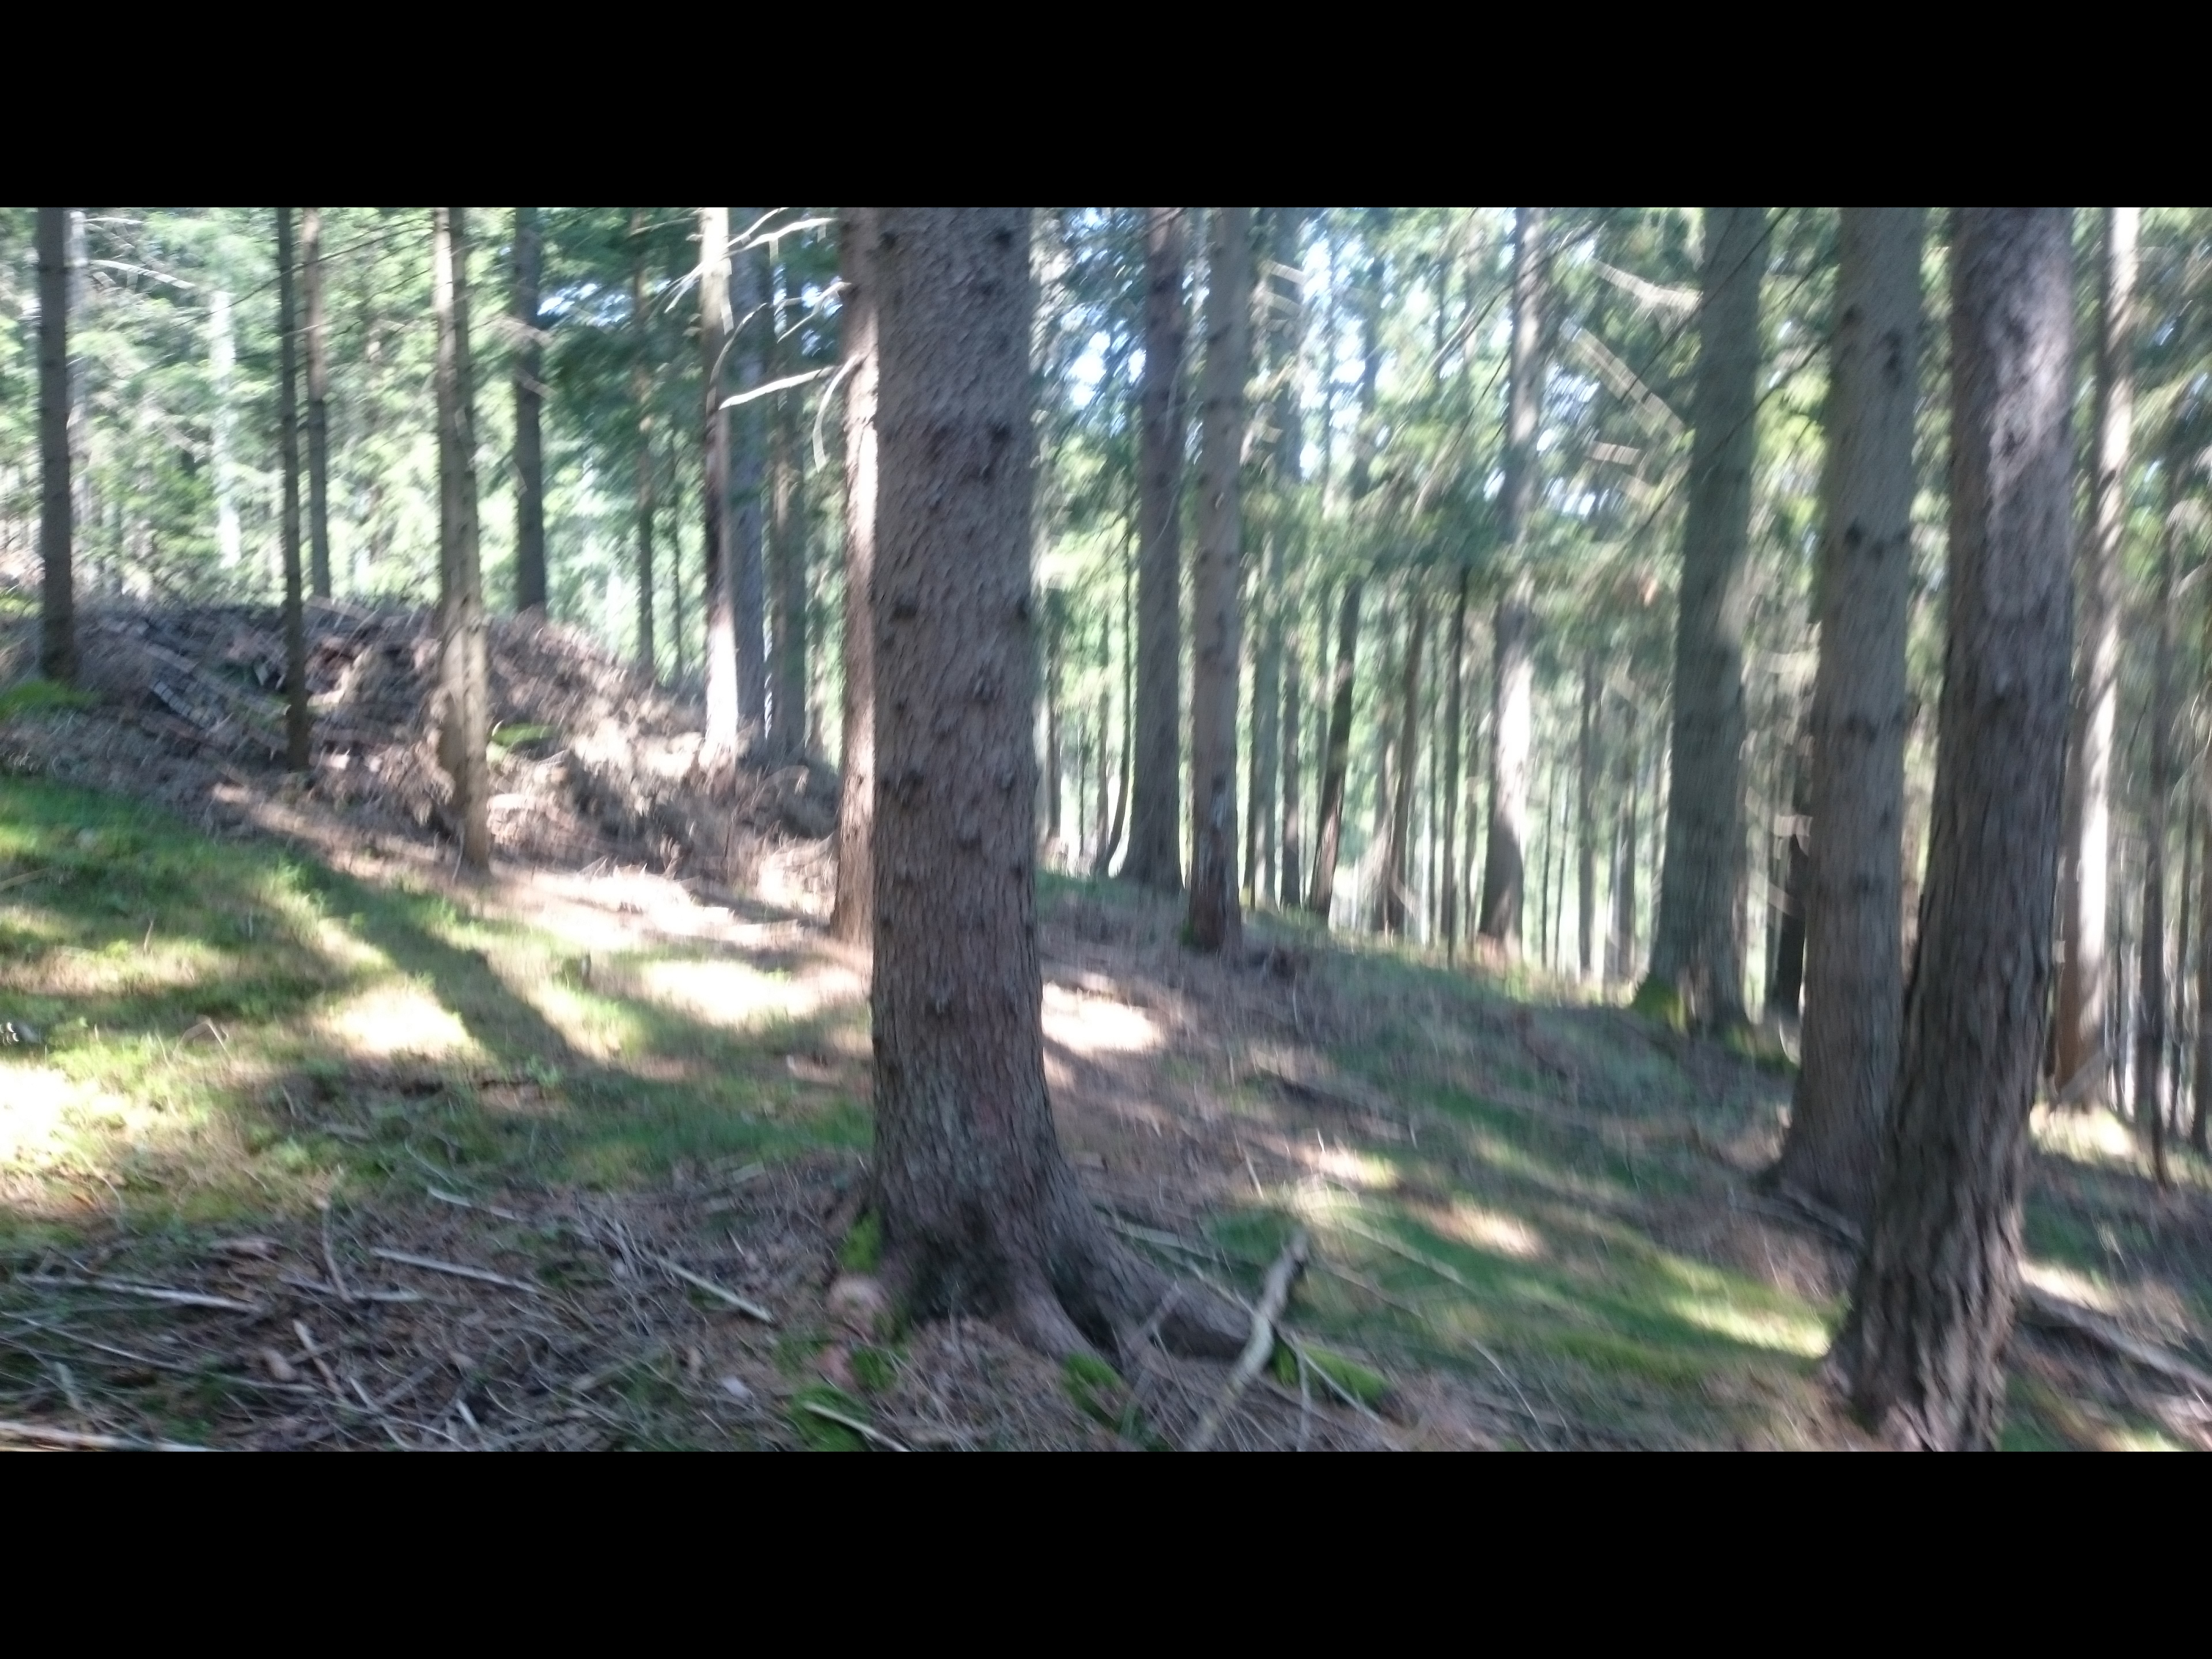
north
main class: Woodland
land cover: Spruce dominated coniferous woodland
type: hemiboreal forest and nemoral coniferous forest and mixed broadleaved-coniferous forest
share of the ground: > 75 %
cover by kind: coniferous forest trees 90 %, consolidated bare surface 10 %
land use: Forestry
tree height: > 5 m
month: July
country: AT
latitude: 47.2021
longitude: 15.5051
